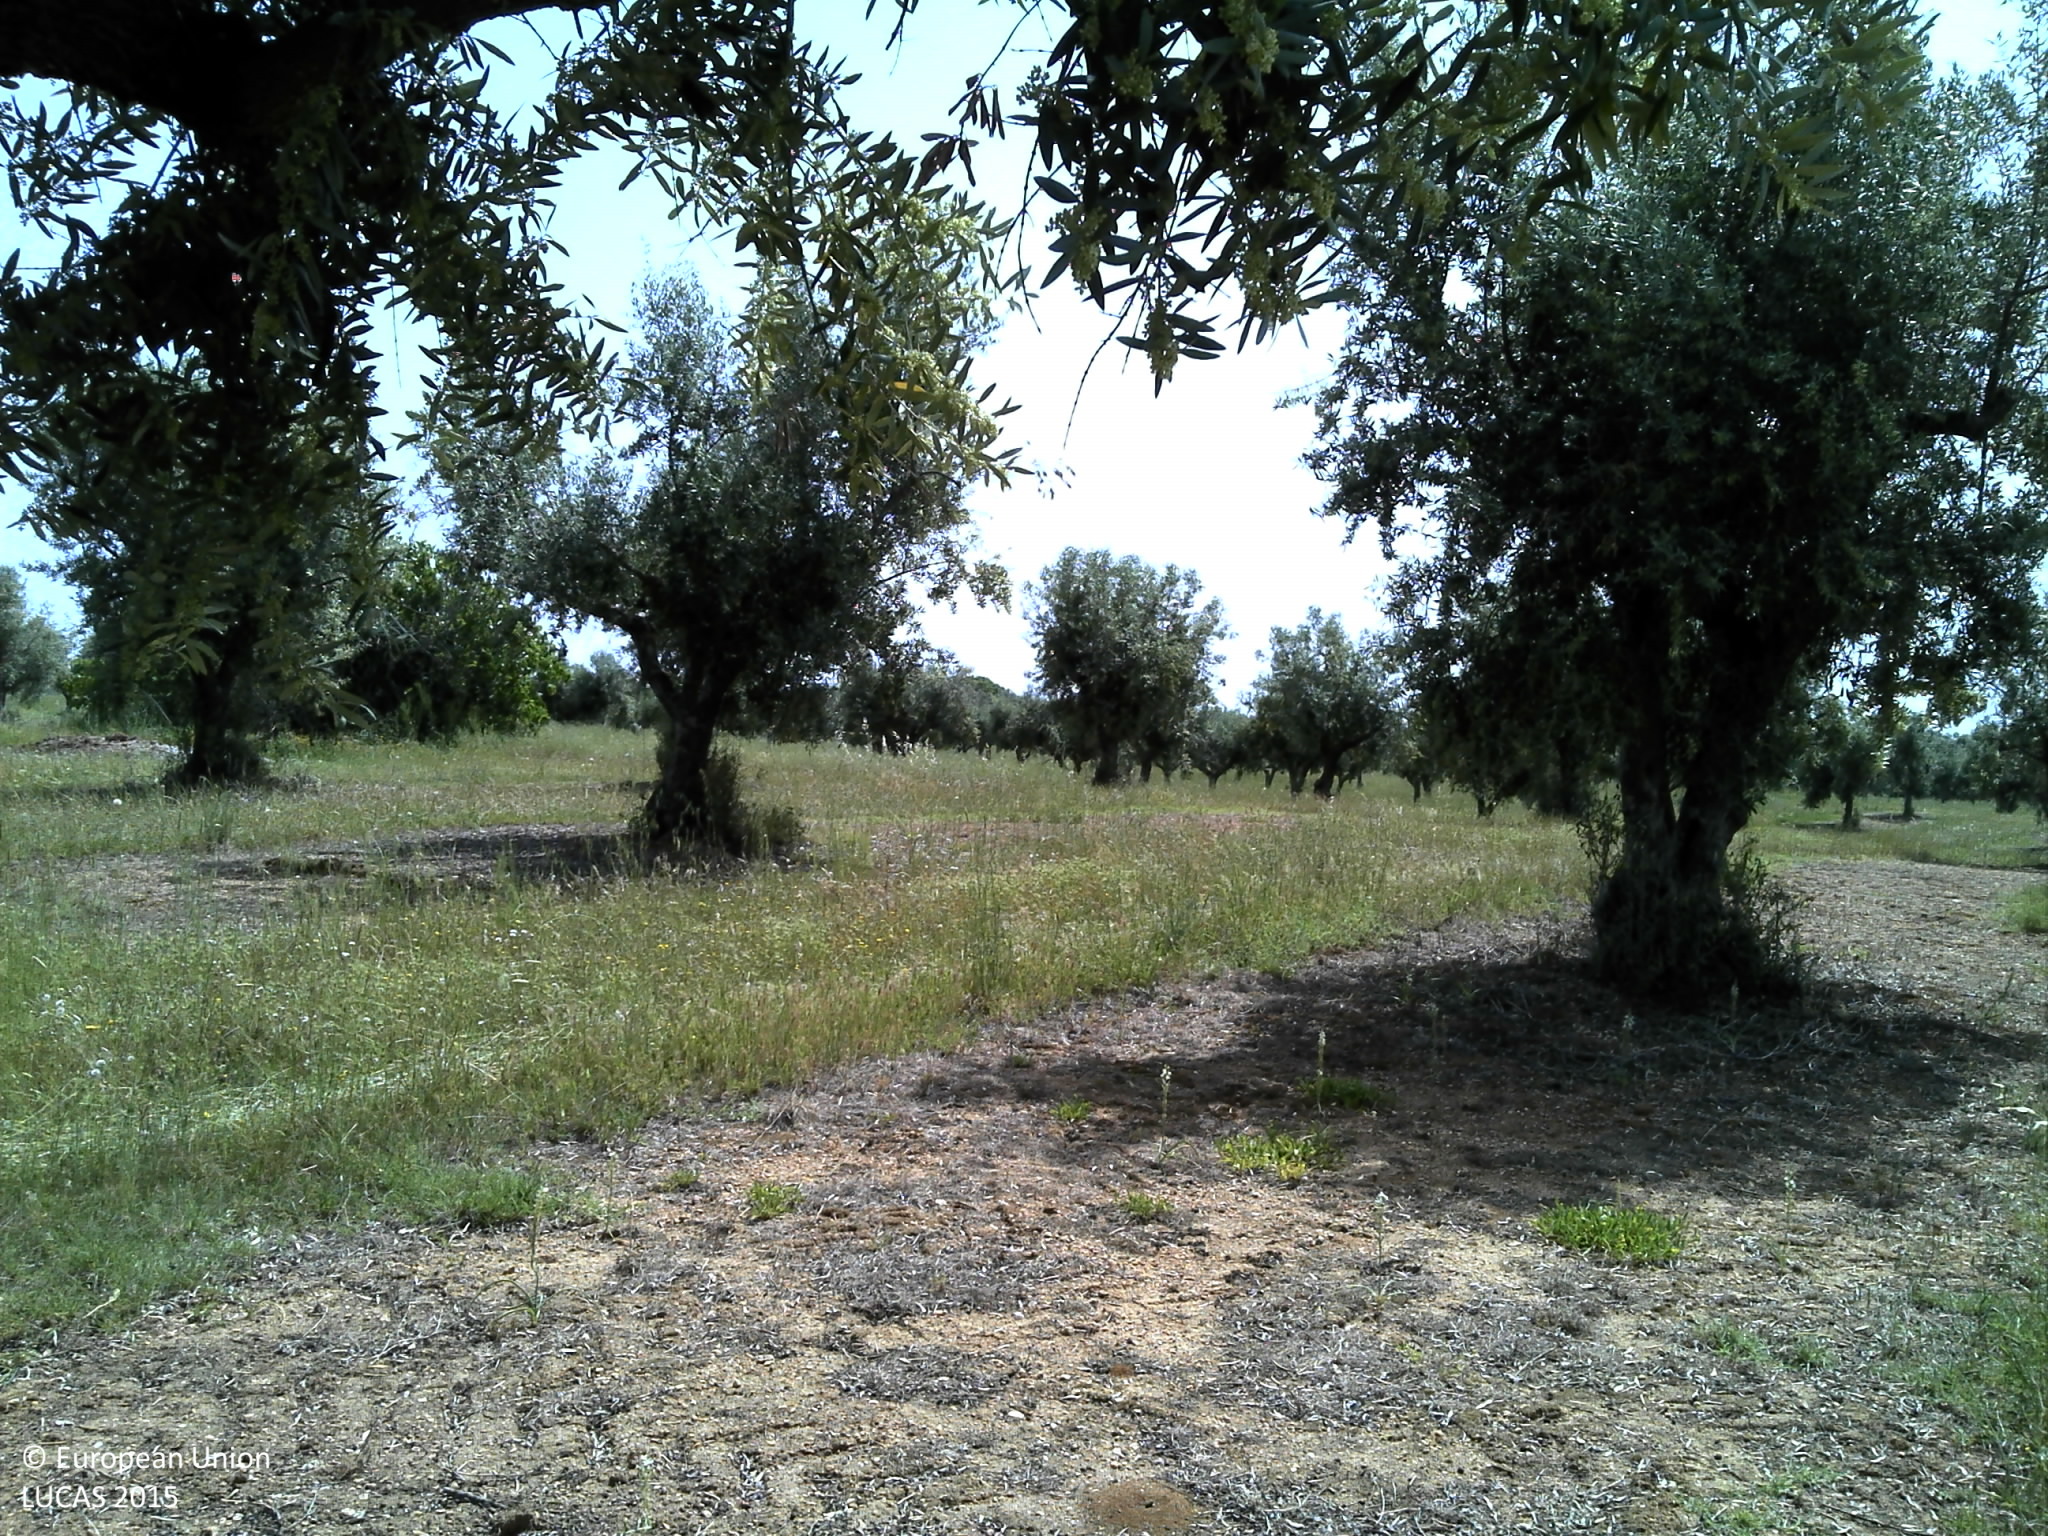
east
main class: Cropland
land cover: Olive groves
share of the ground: 25 - 50 %
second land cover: Grassland without tree/shrub cover
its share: 10 - 25 %
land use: Agriculture (excluding fallow land and kitchen gardens)
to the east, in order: Olive groves; Grassland without tree/shrub cover; Olive groves
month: May
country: PT
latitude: 38.9482
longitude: -7.8488
